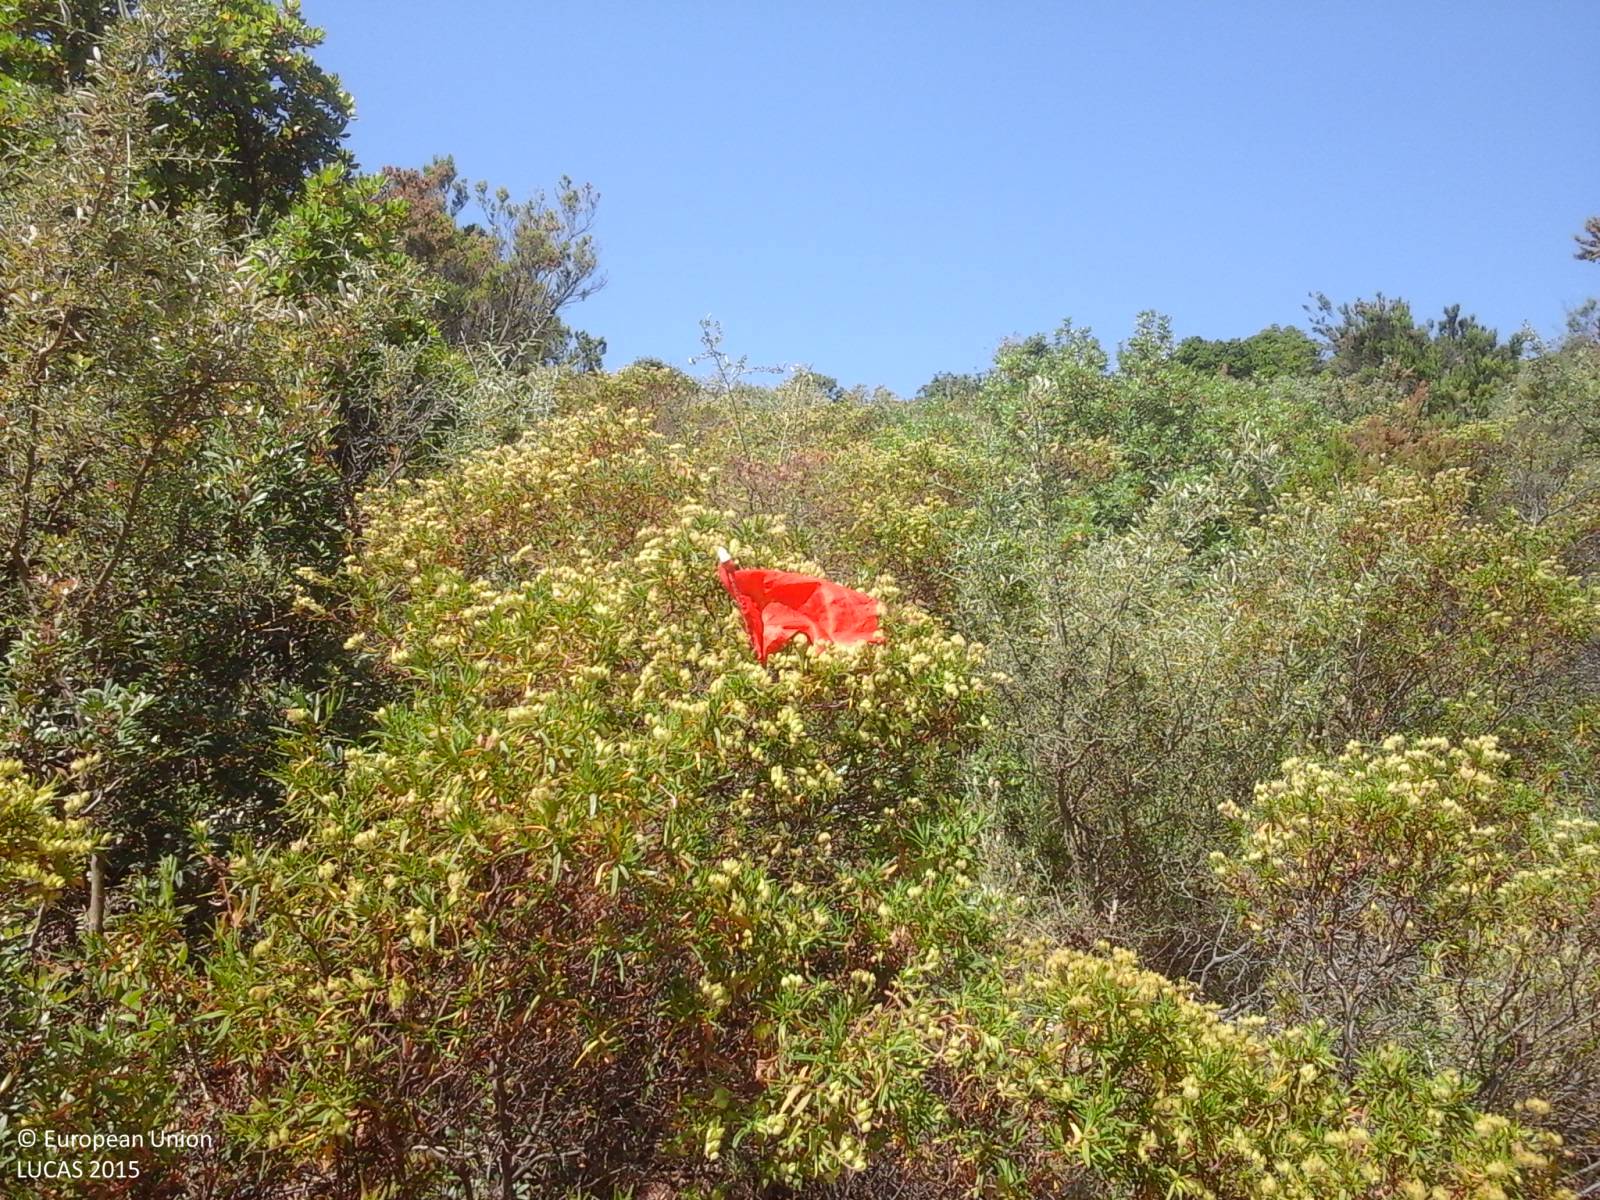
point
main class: Shrubland
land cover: Shrubland without tree cover
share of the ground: > 75 %
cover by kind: shrubs 90 %, herbaceous plants 10 %
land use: Semi-natural and natural areas not in use
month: June
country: IT
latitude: 38.9561
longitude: 8.8420
